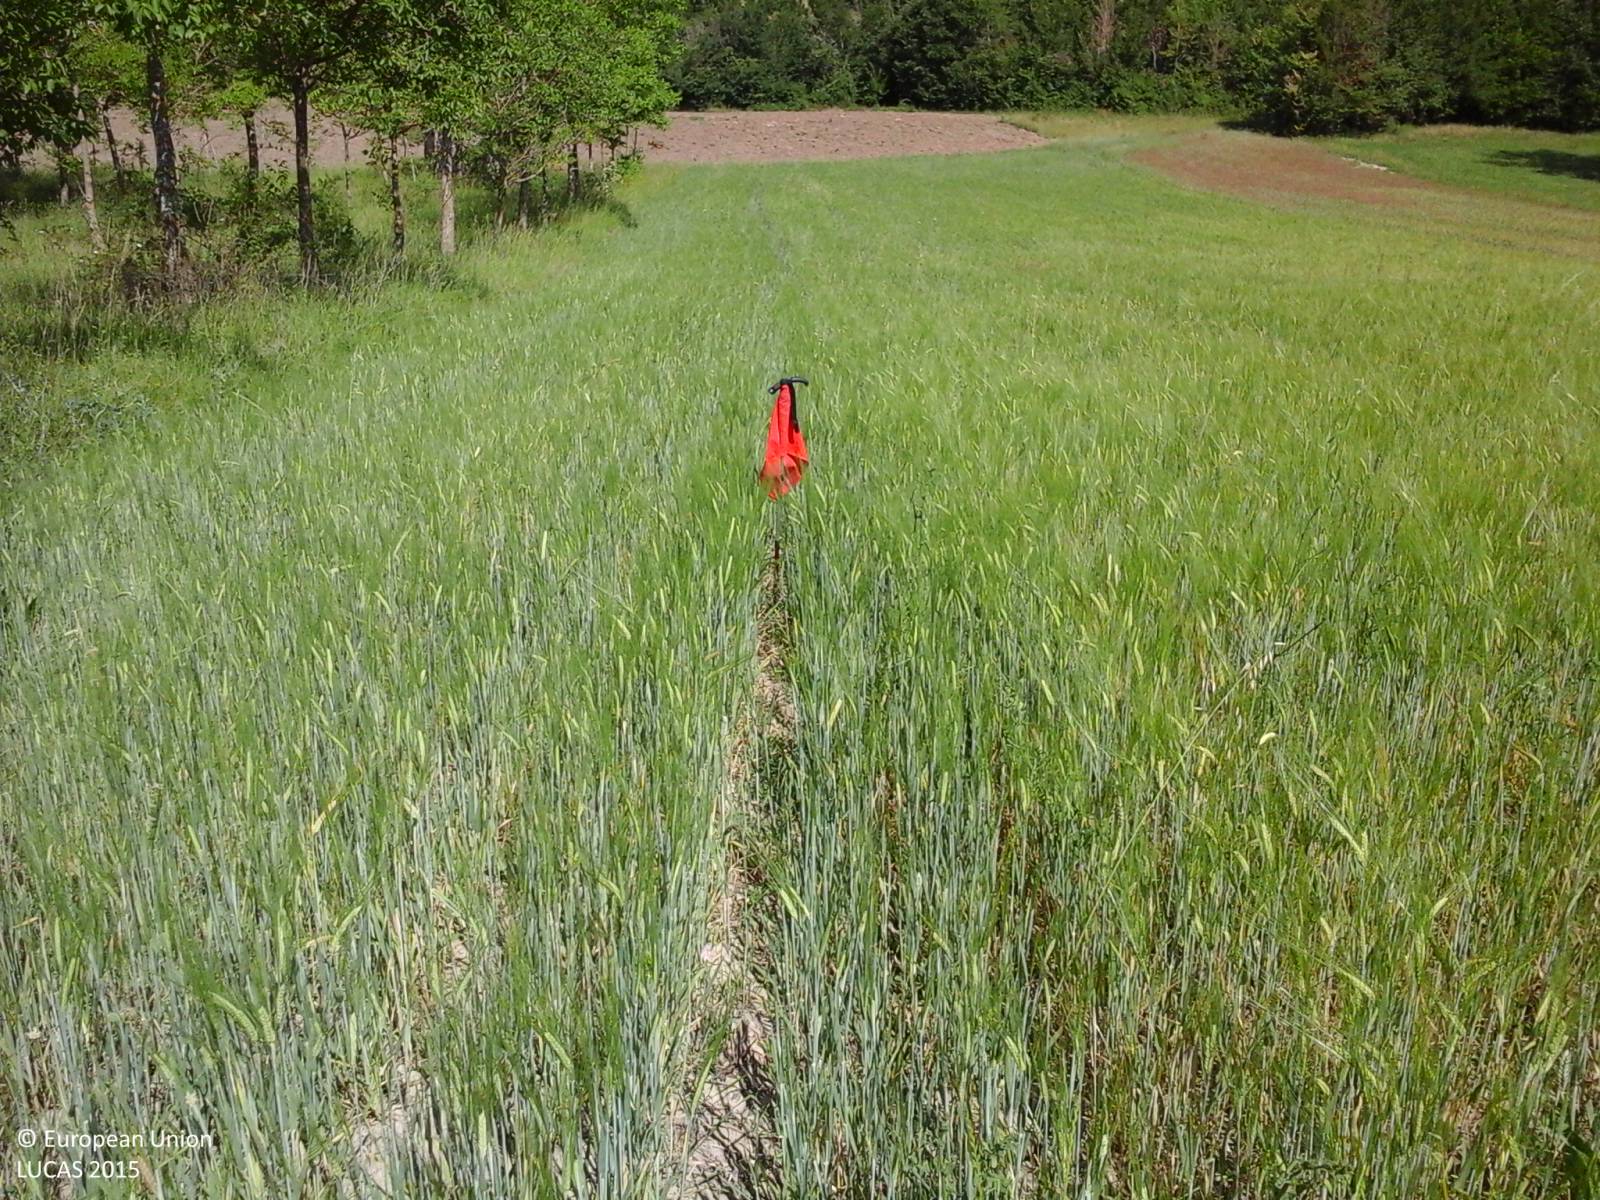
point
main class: Cropland
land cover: Barley
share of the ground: > 75 %
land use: Agriculture (excluding fallow land and kitchen gardens)
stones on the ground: < 10 %
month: June
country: IT
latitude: 42.1154
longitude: 13.7249
